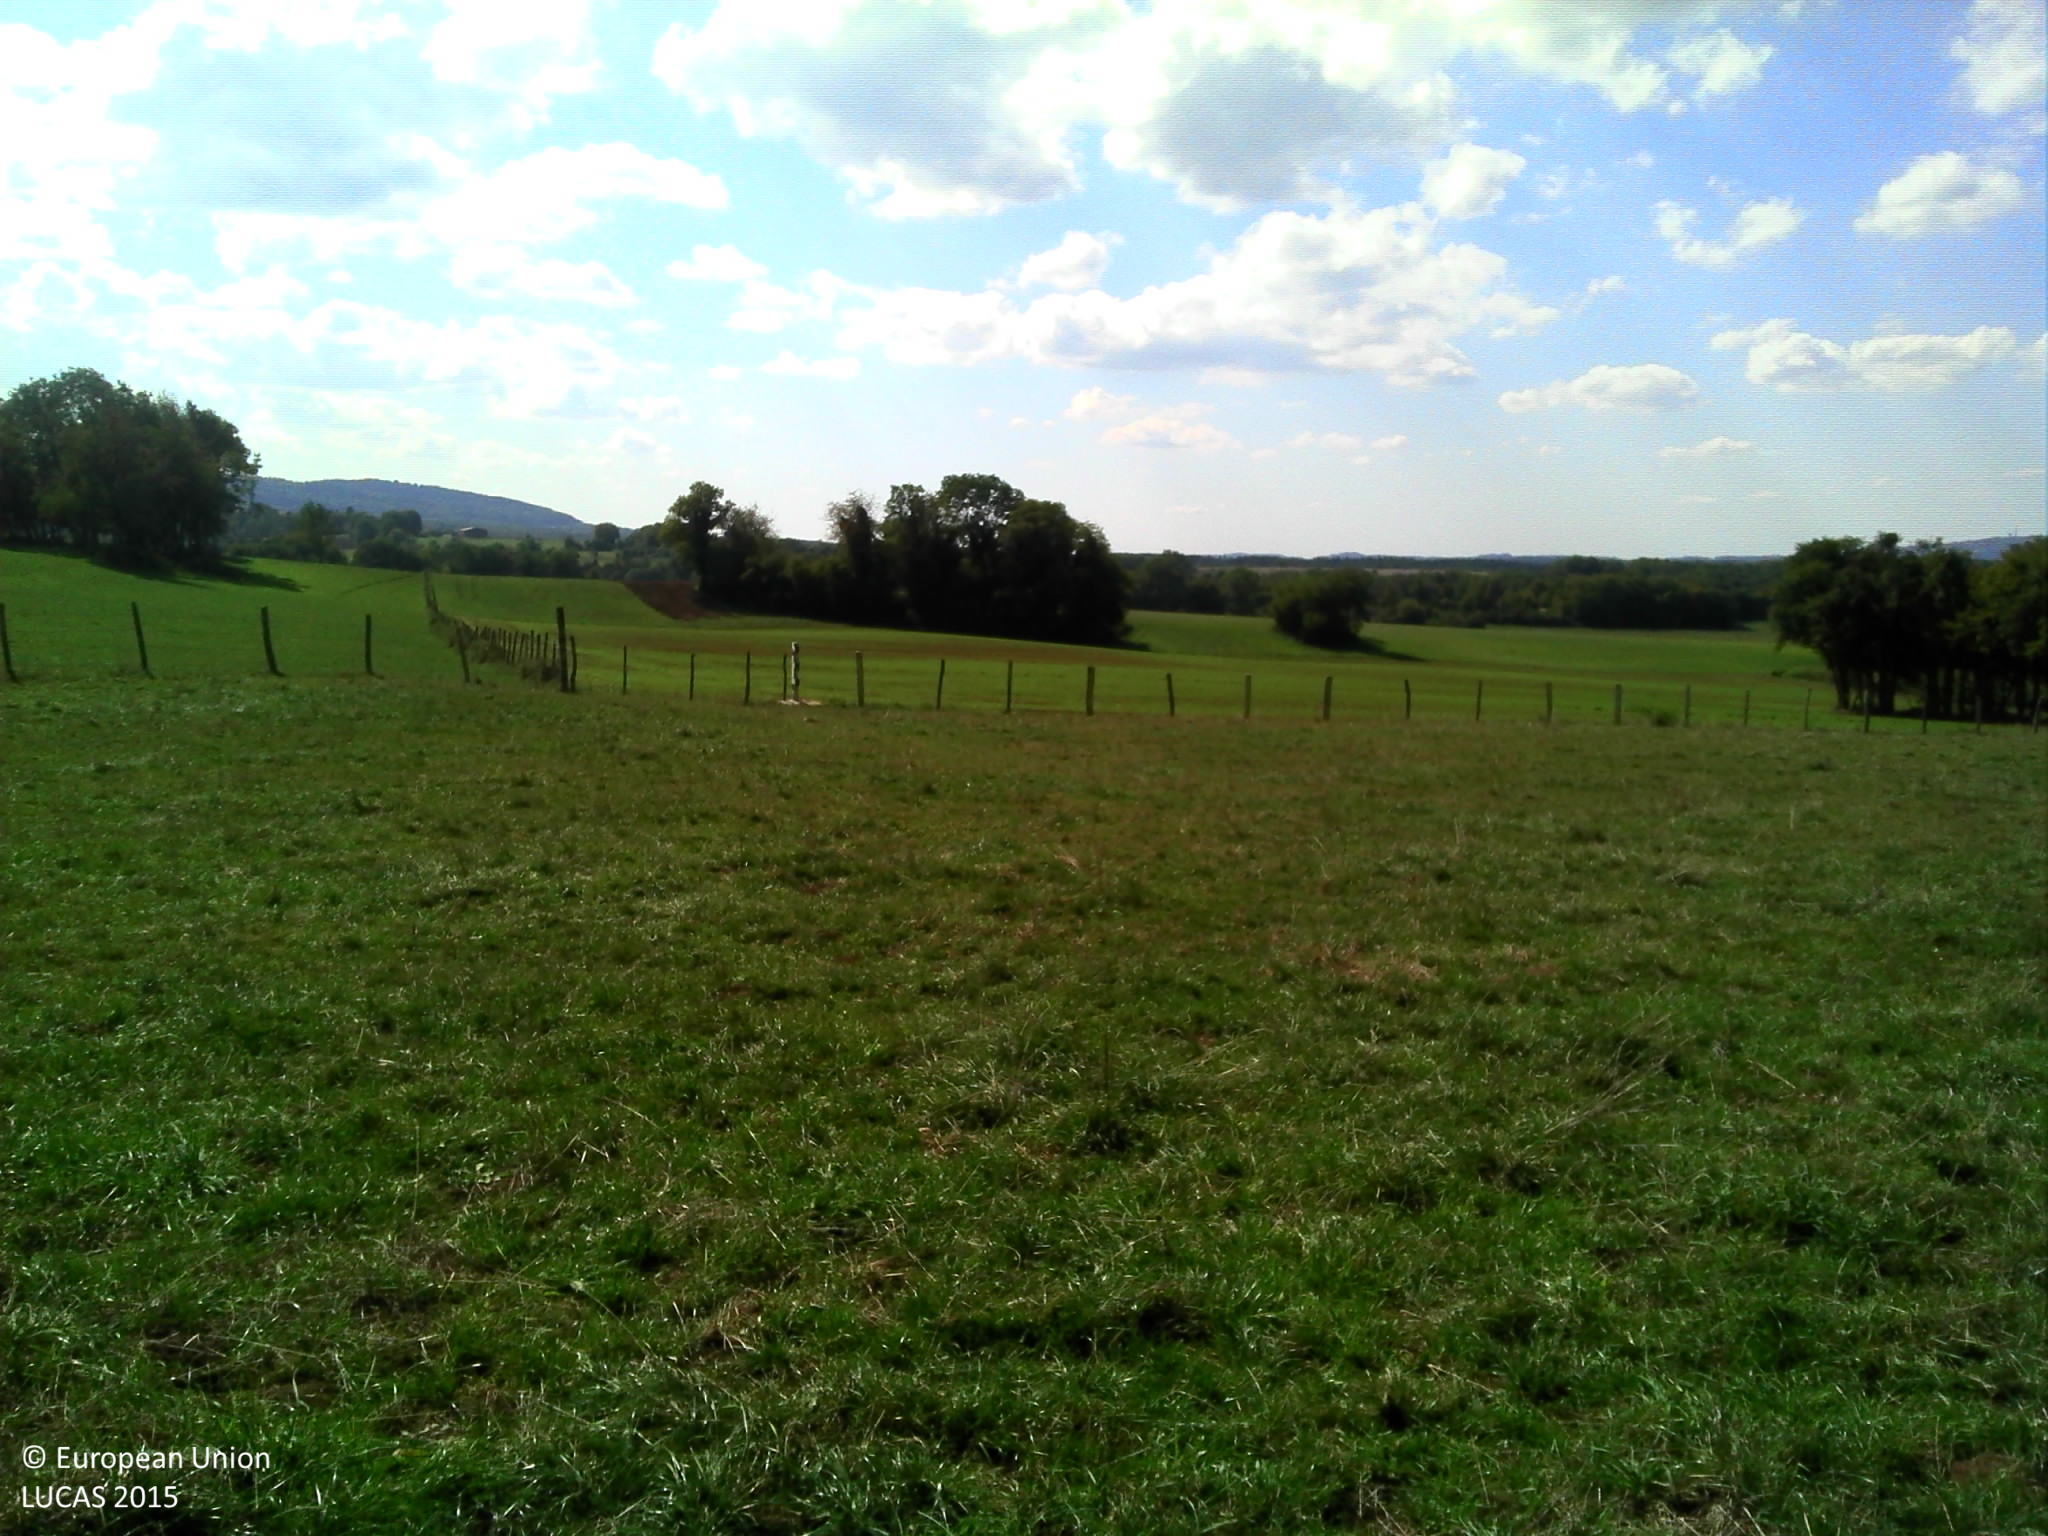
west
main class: Grassland
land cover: Grassland without tree/shrub cover
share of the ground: > 75 %
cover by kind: herbaceous plants 100 %
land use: Agriculture (excluding fallow land and kitchen gardens)
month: September
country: FR
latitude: 47.2225
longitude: 6.2382
